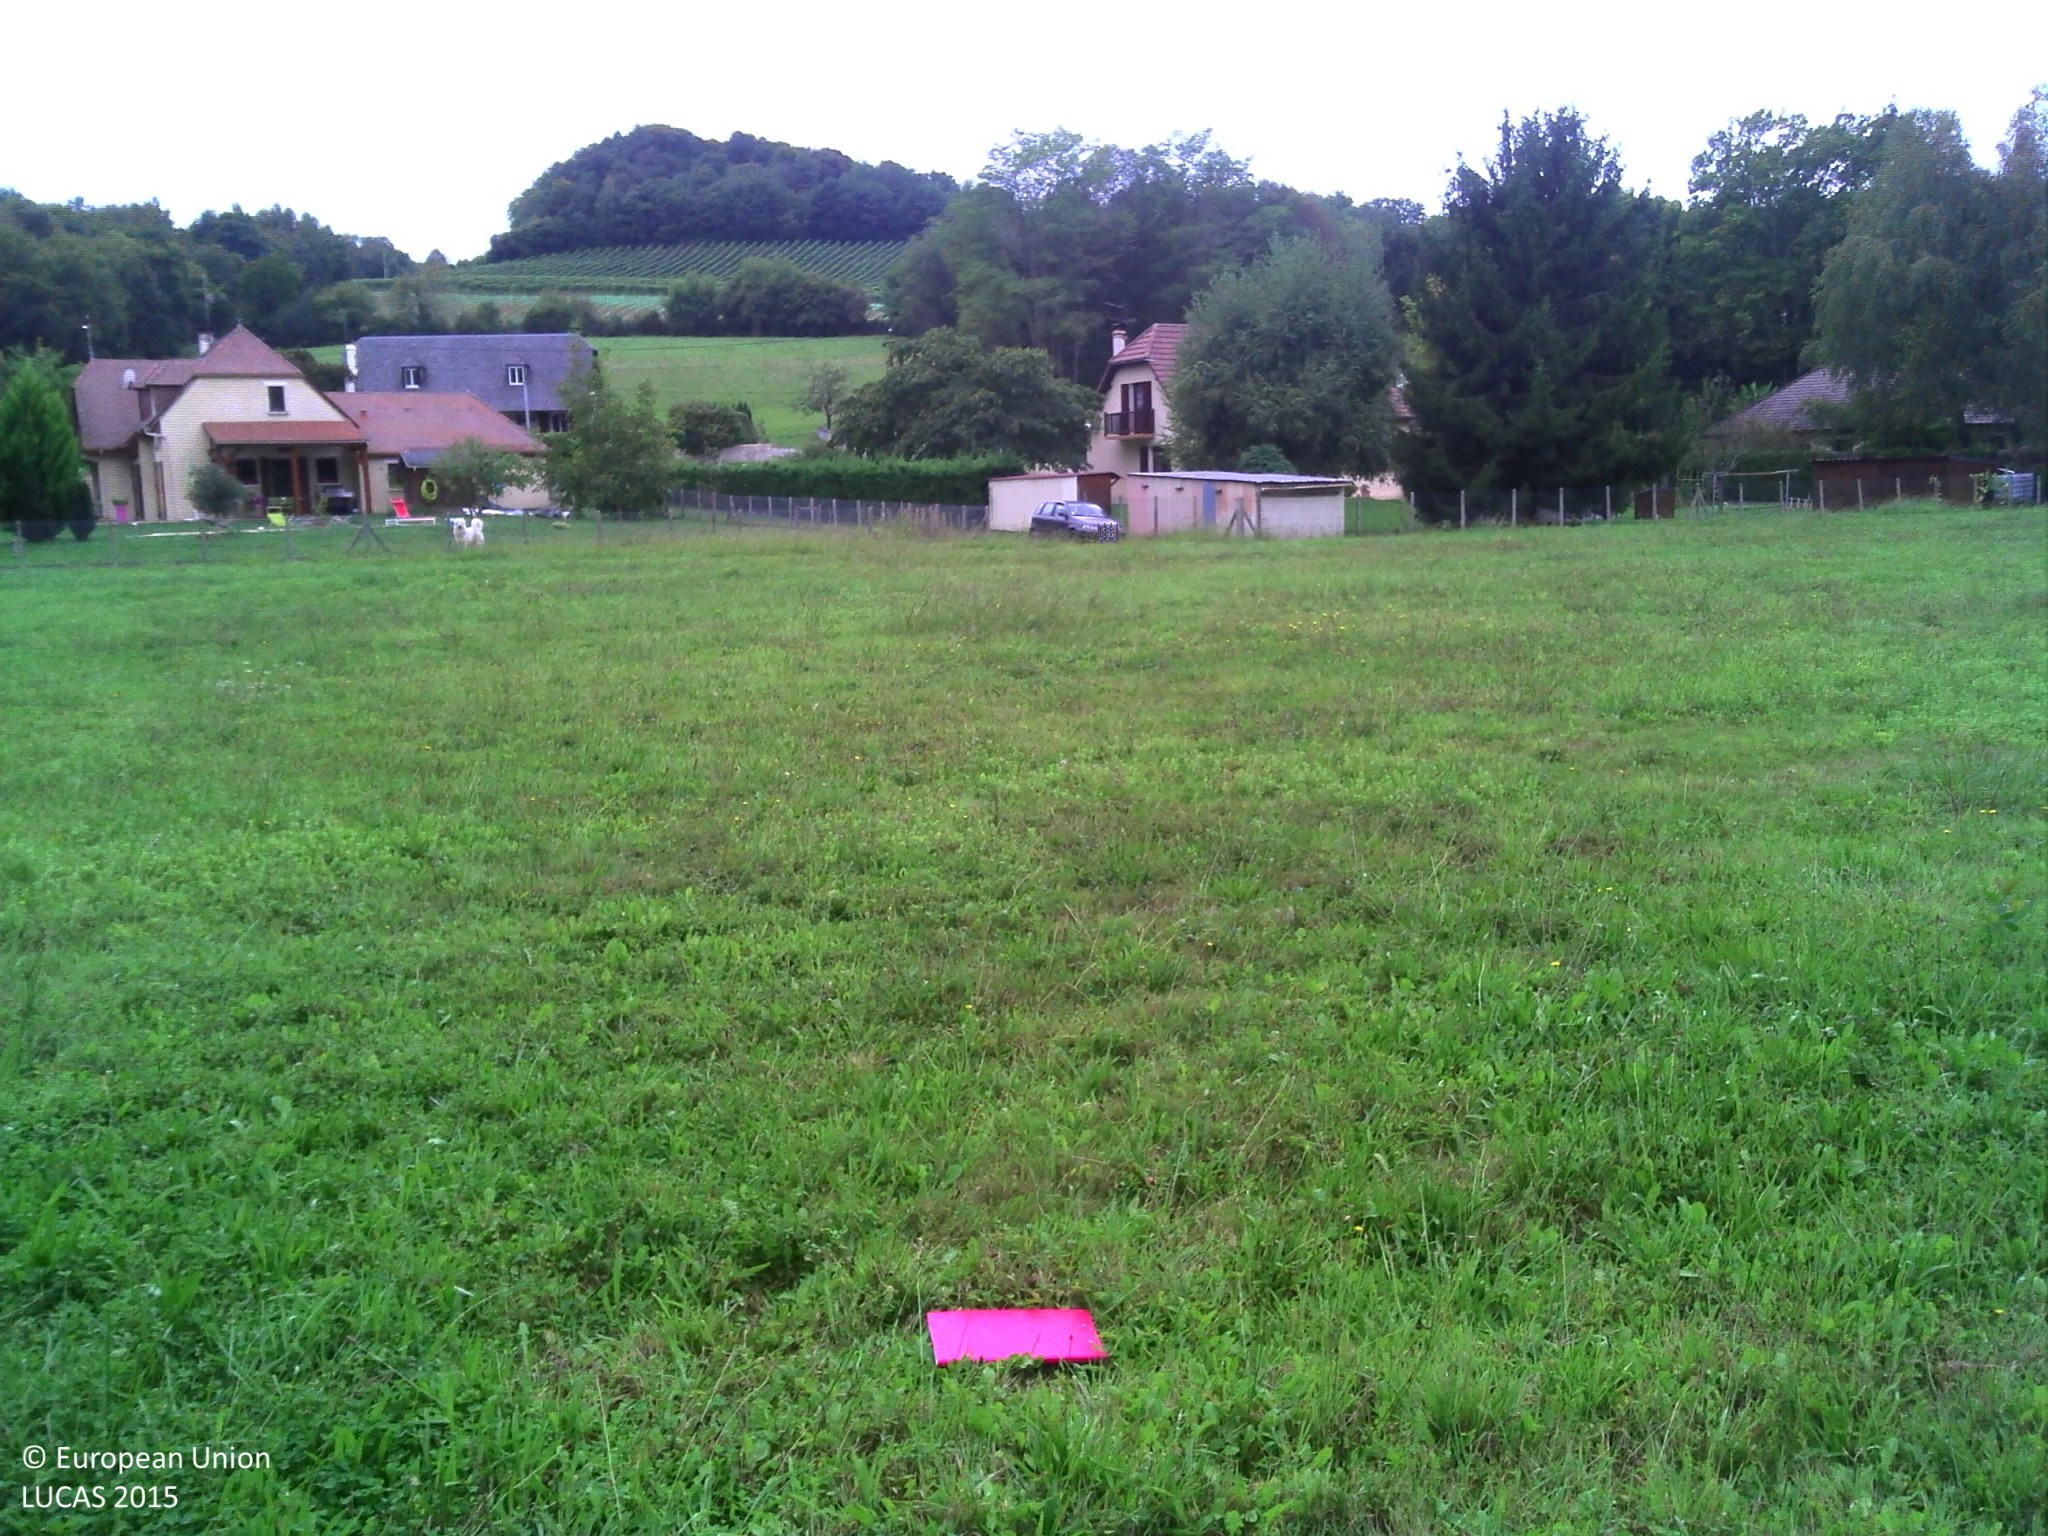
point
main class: Grassland
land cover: Grassland without tree/shrub cover
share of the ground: > 75 %
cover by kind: herbaceous plants 100 %
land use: Agriculture (excluding fallow land and kitchen gardens)
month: September
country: FR
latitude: 43.3100
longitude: -0.4749
